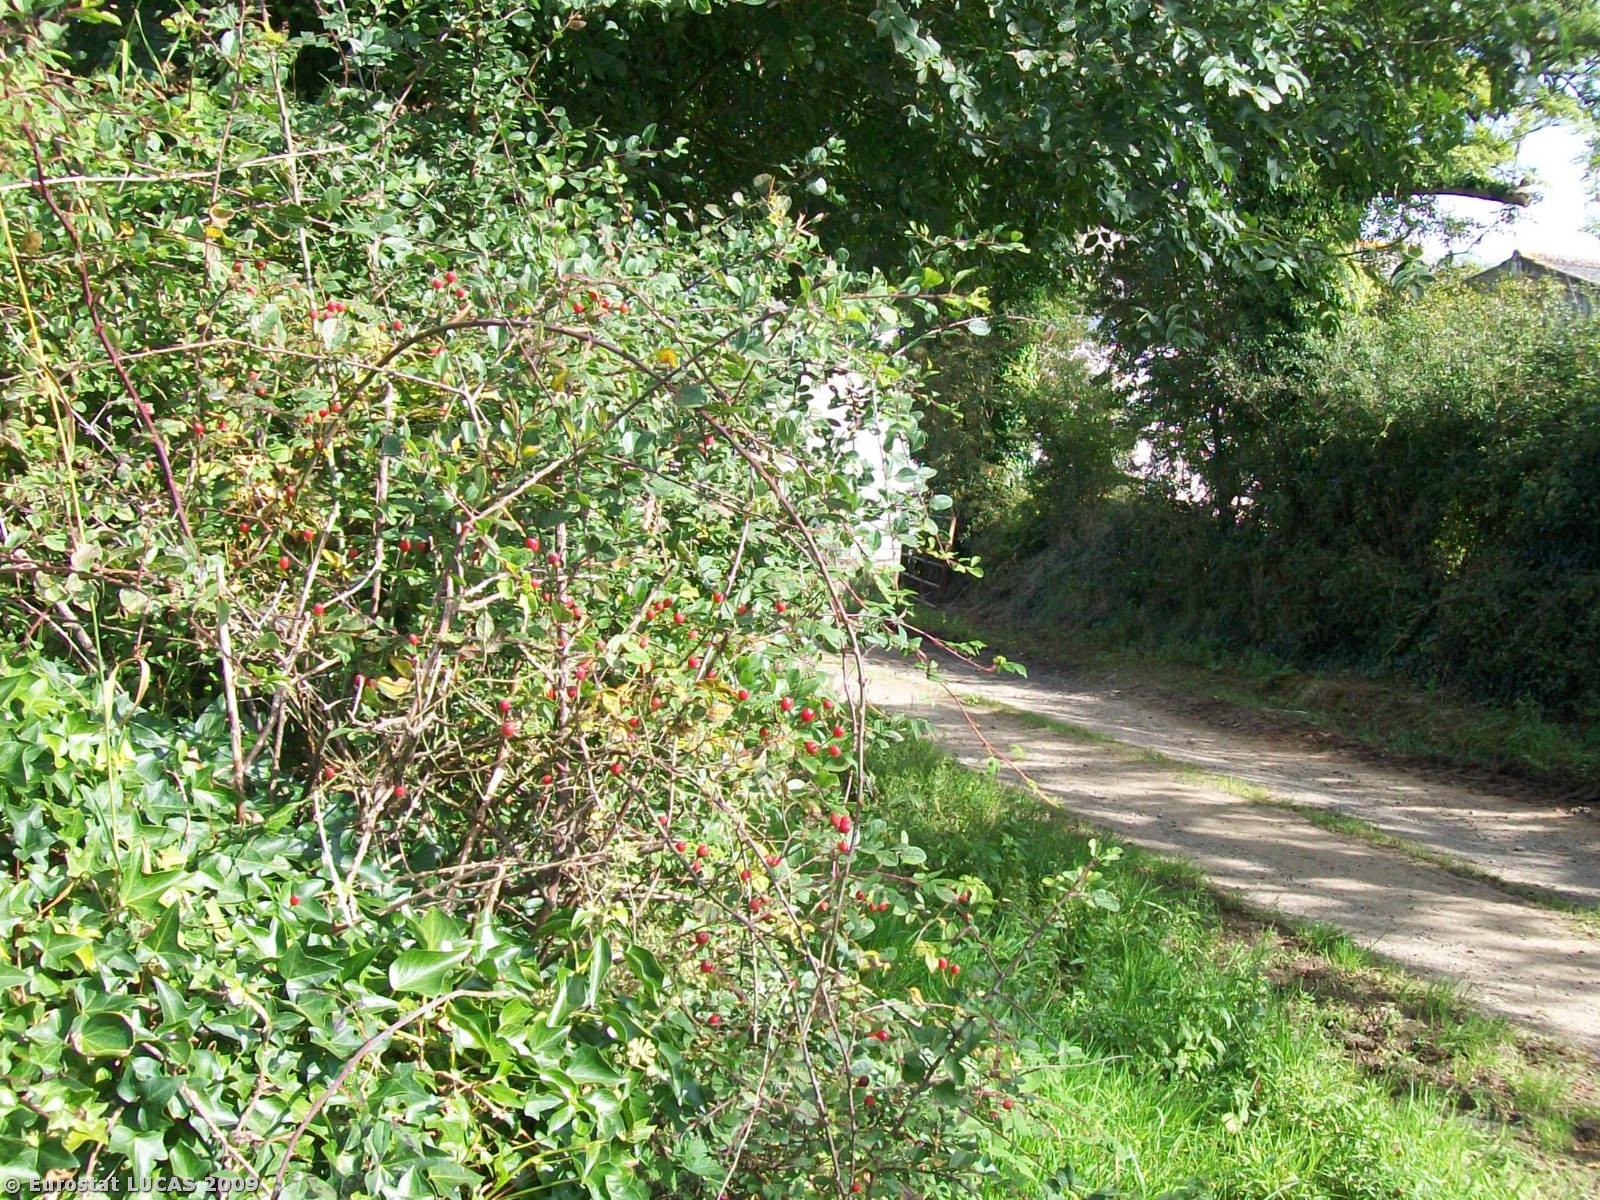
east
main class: Grassland
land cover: Grassland without tree/shrub cover
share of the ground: > 75 %
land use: Agriculture (excluding fallow land and kitchen gardens)
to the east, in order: Grassland without tree/shrub cover; Managed hedges; Single bushes/trees; Abandoned hedges; Tracks; Shrubland without tree cover; Grassland without tree/shrub cover
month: September
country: GB
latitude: 51.7435
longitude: -5.0206
